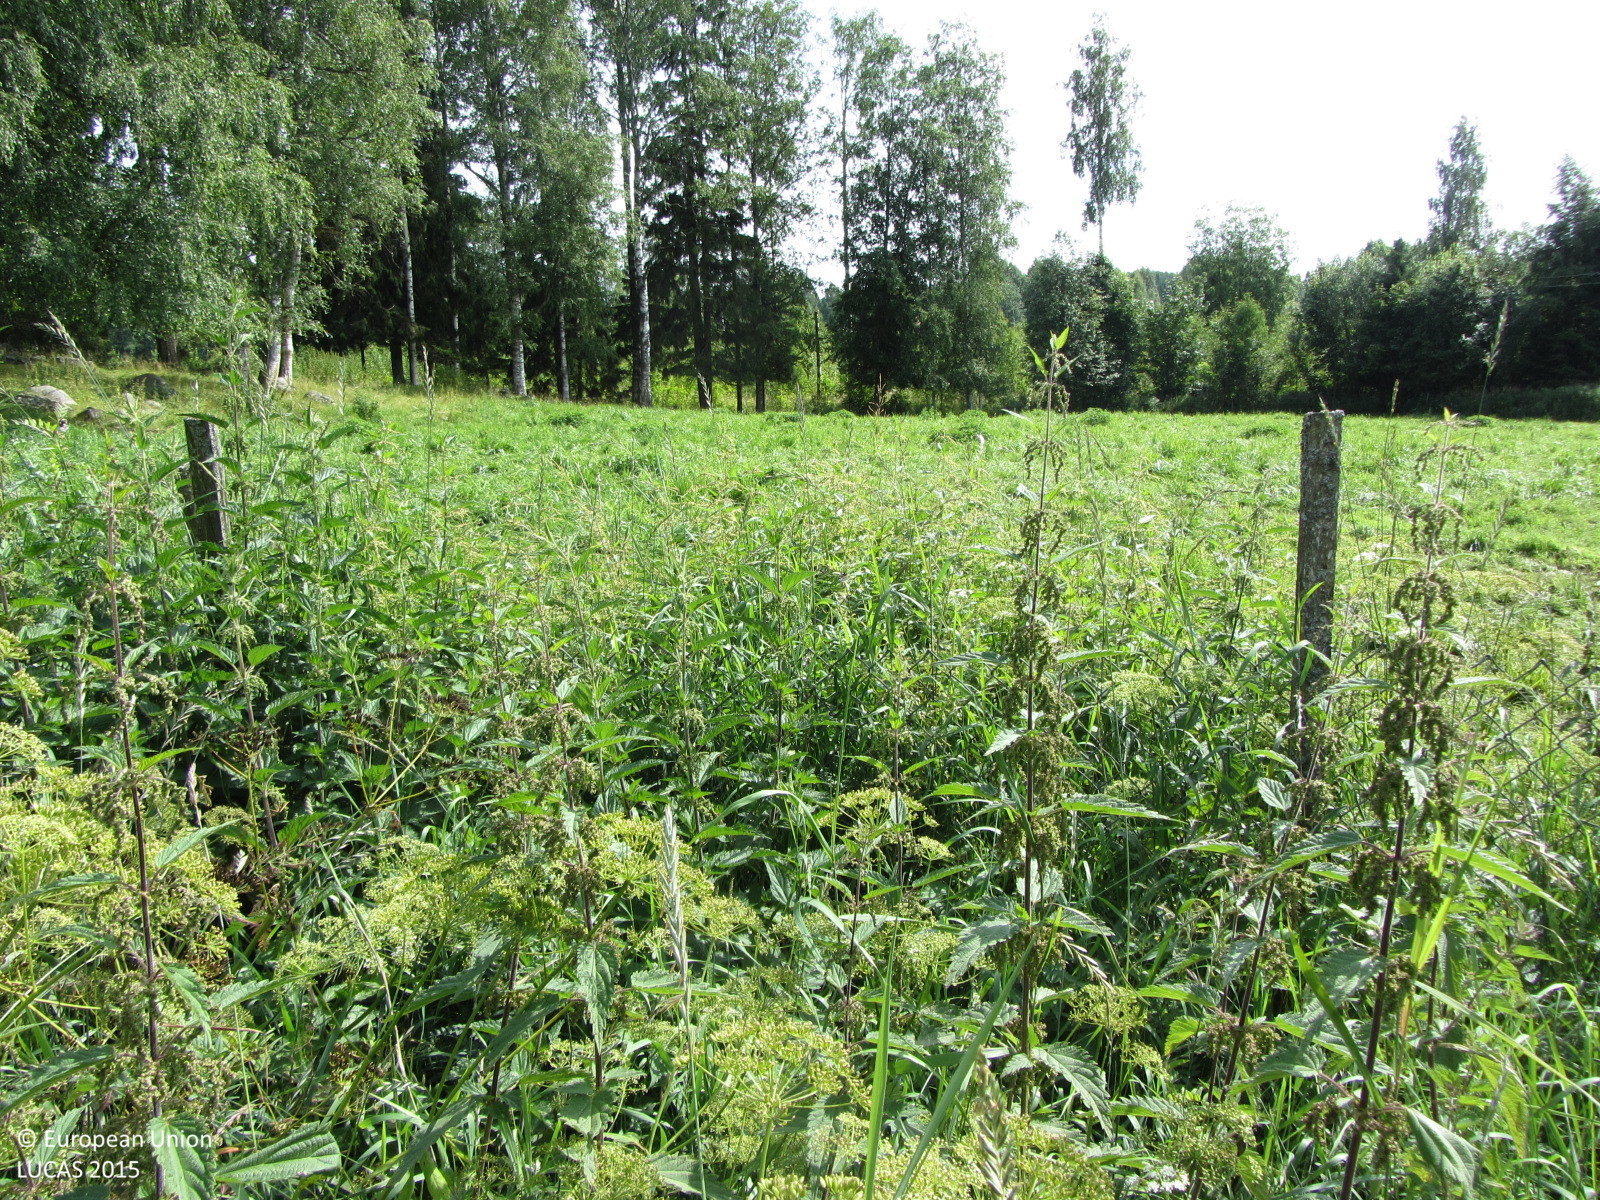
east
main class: Cropland
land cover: Other fruit trees and berries
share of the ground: 50 - 75 %
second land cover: Apple fruit
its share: 25 - 50 %
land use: Kitchen garden
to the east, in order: Other fruit trees and berries; Apple fruit; Fences; Grass margins; Temporary grasslands; Spruce dominated mixed woodland; Fences; Broadleaved woodland; Ditches and canals; Grass margins; Paved roads, cycling and walking lanes; Spontaneously vegetated surfaces; Ditches and canals; Broadleaved woodland; Ditches and canals; Grass margins; Oats; Potatoes
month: July
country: FI
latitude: 60.5887
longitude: 24.4348
